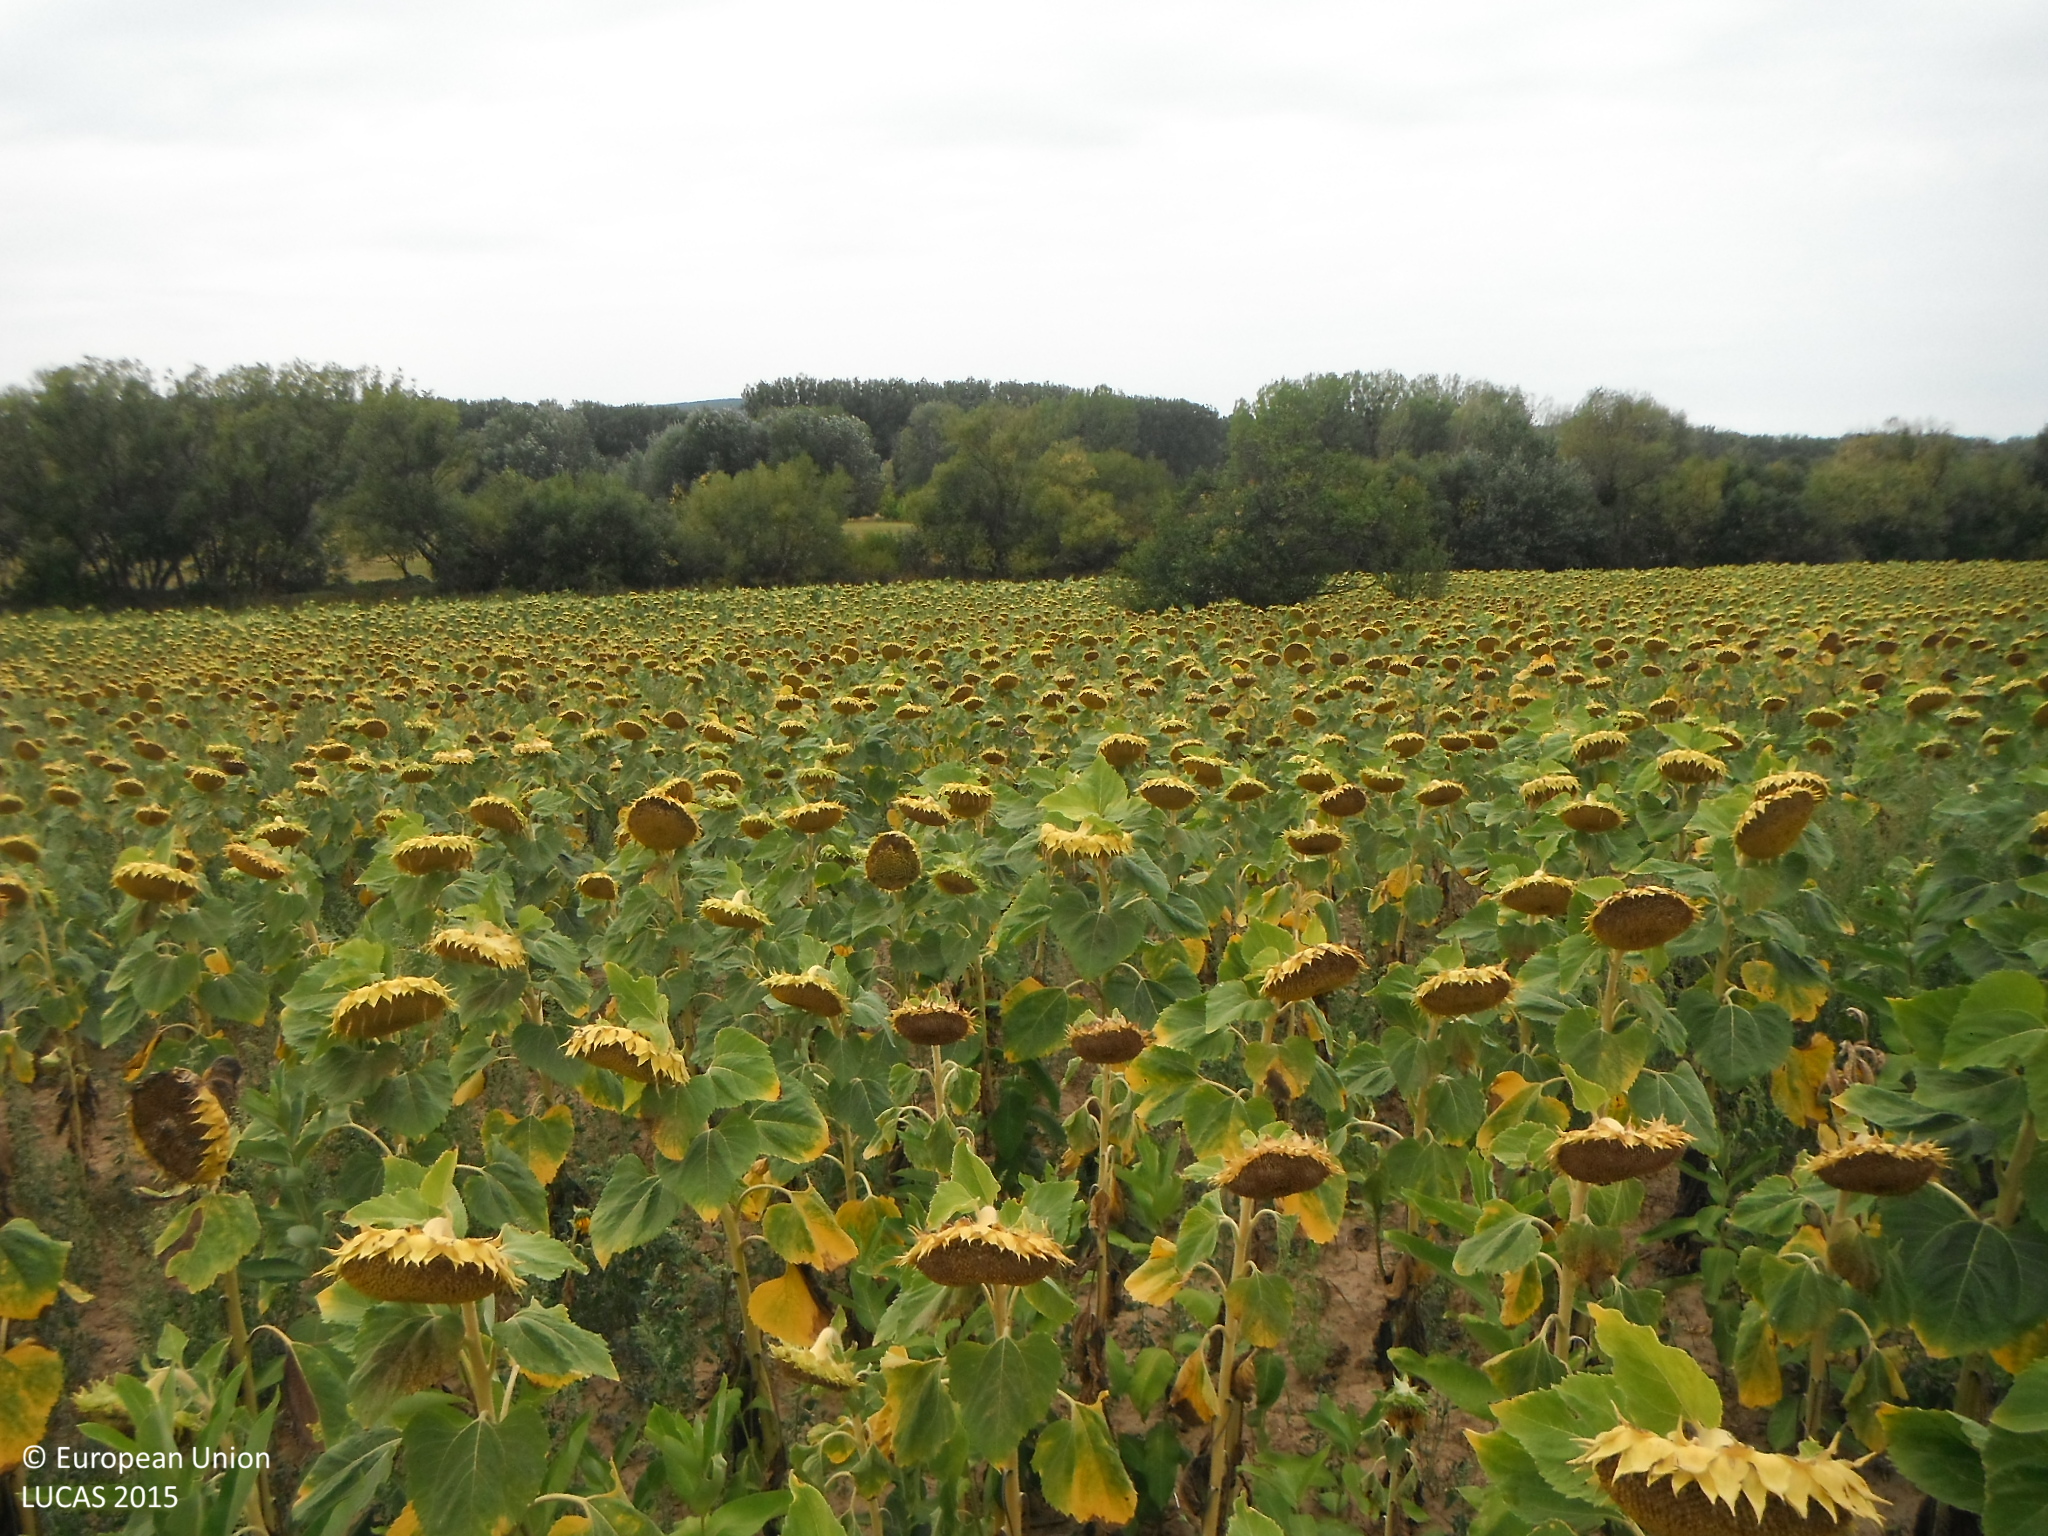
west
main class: Cropland
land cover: Sunflower
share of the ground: > 75 %
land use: Agriculture (excluding fallow land and kitchen gardens)
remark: Harvested field
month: August
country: SK
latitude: 48.4775
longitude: 21.8068
